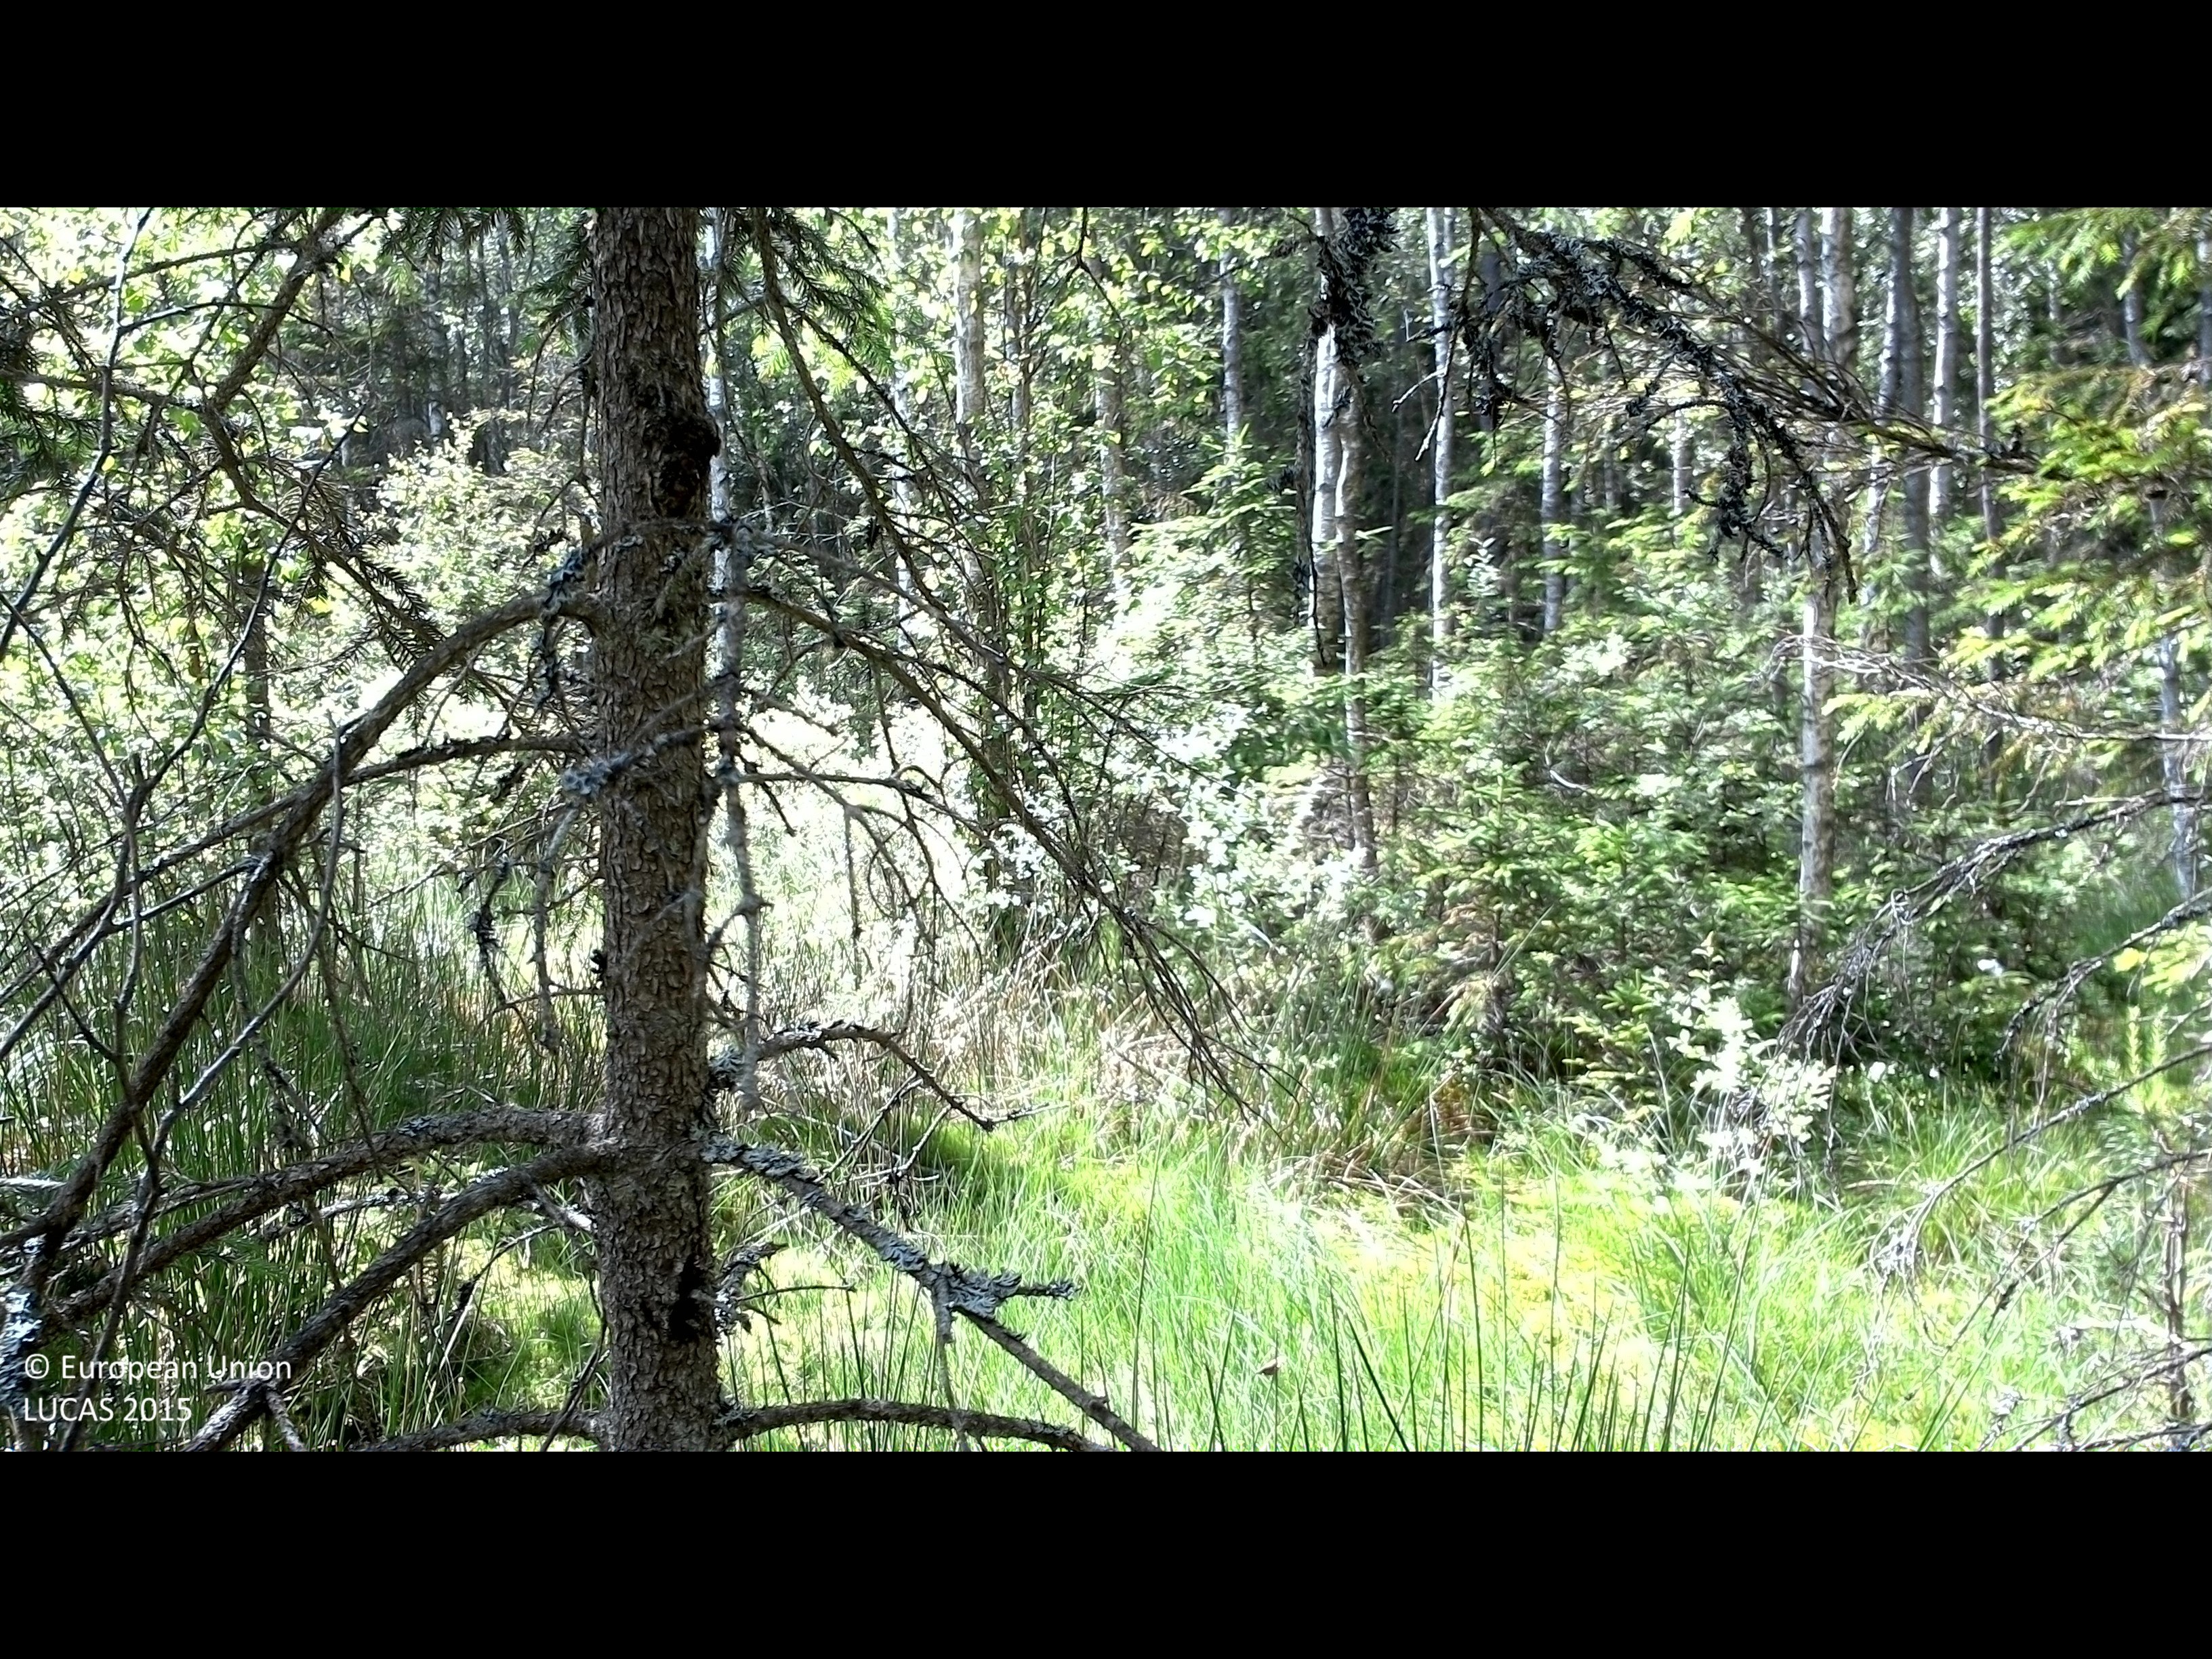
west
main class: Woodland
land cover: Broadleaved woodland
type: boreal forest
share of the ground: 50 - 75 %
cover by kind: broadleaved forest trees 50 %, lichens and mosses 25 %, coniferous forest trees 10 %, herbaceous plants 10 %, shrubs 5 %
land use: Forestry
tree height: > 5 m
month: July
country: SE
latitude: 56.4260
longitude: 15.1707
